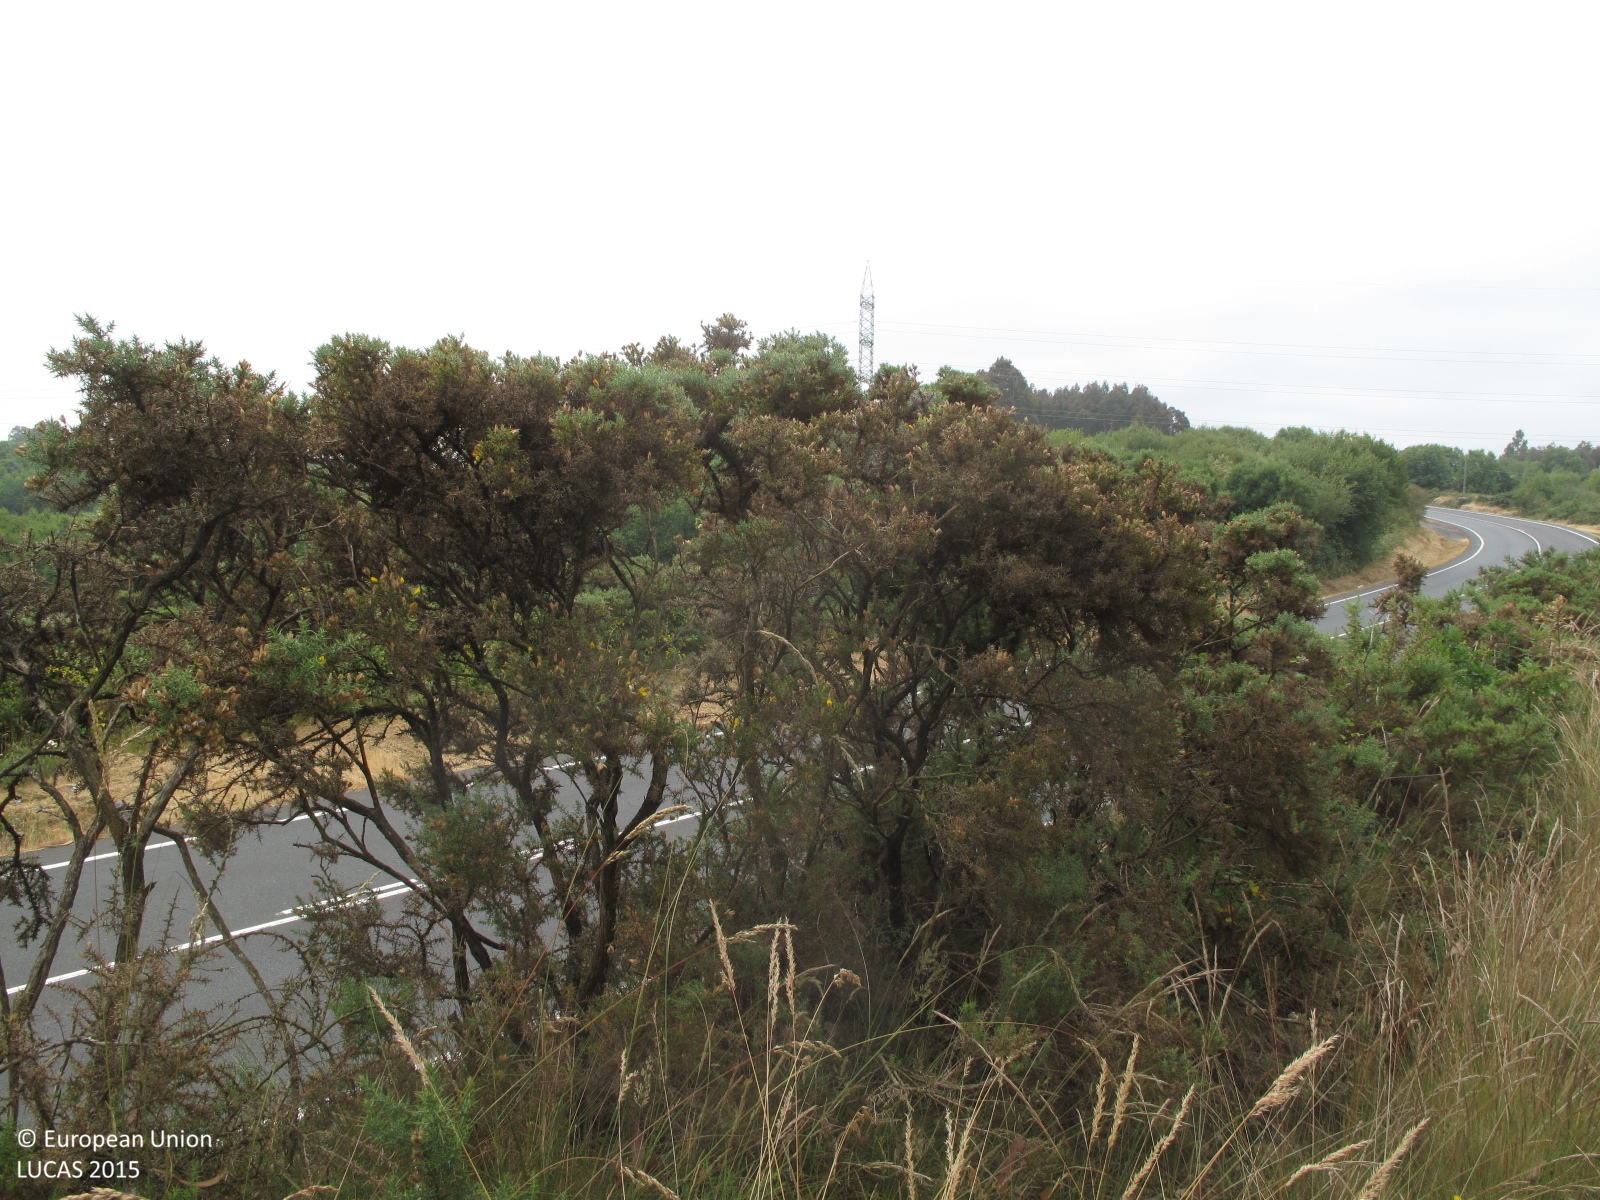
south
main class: Woodland
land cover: Broadleaved woodland
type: exotic forest
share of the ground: 25 - 50 %
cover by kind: herbaceous plants 50 %, broadleaved forest trees 40 %, shrubs 10 %
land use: Forestry
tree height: < 5 m
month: June
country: ES
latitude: 43.1597
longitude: -8.0367
